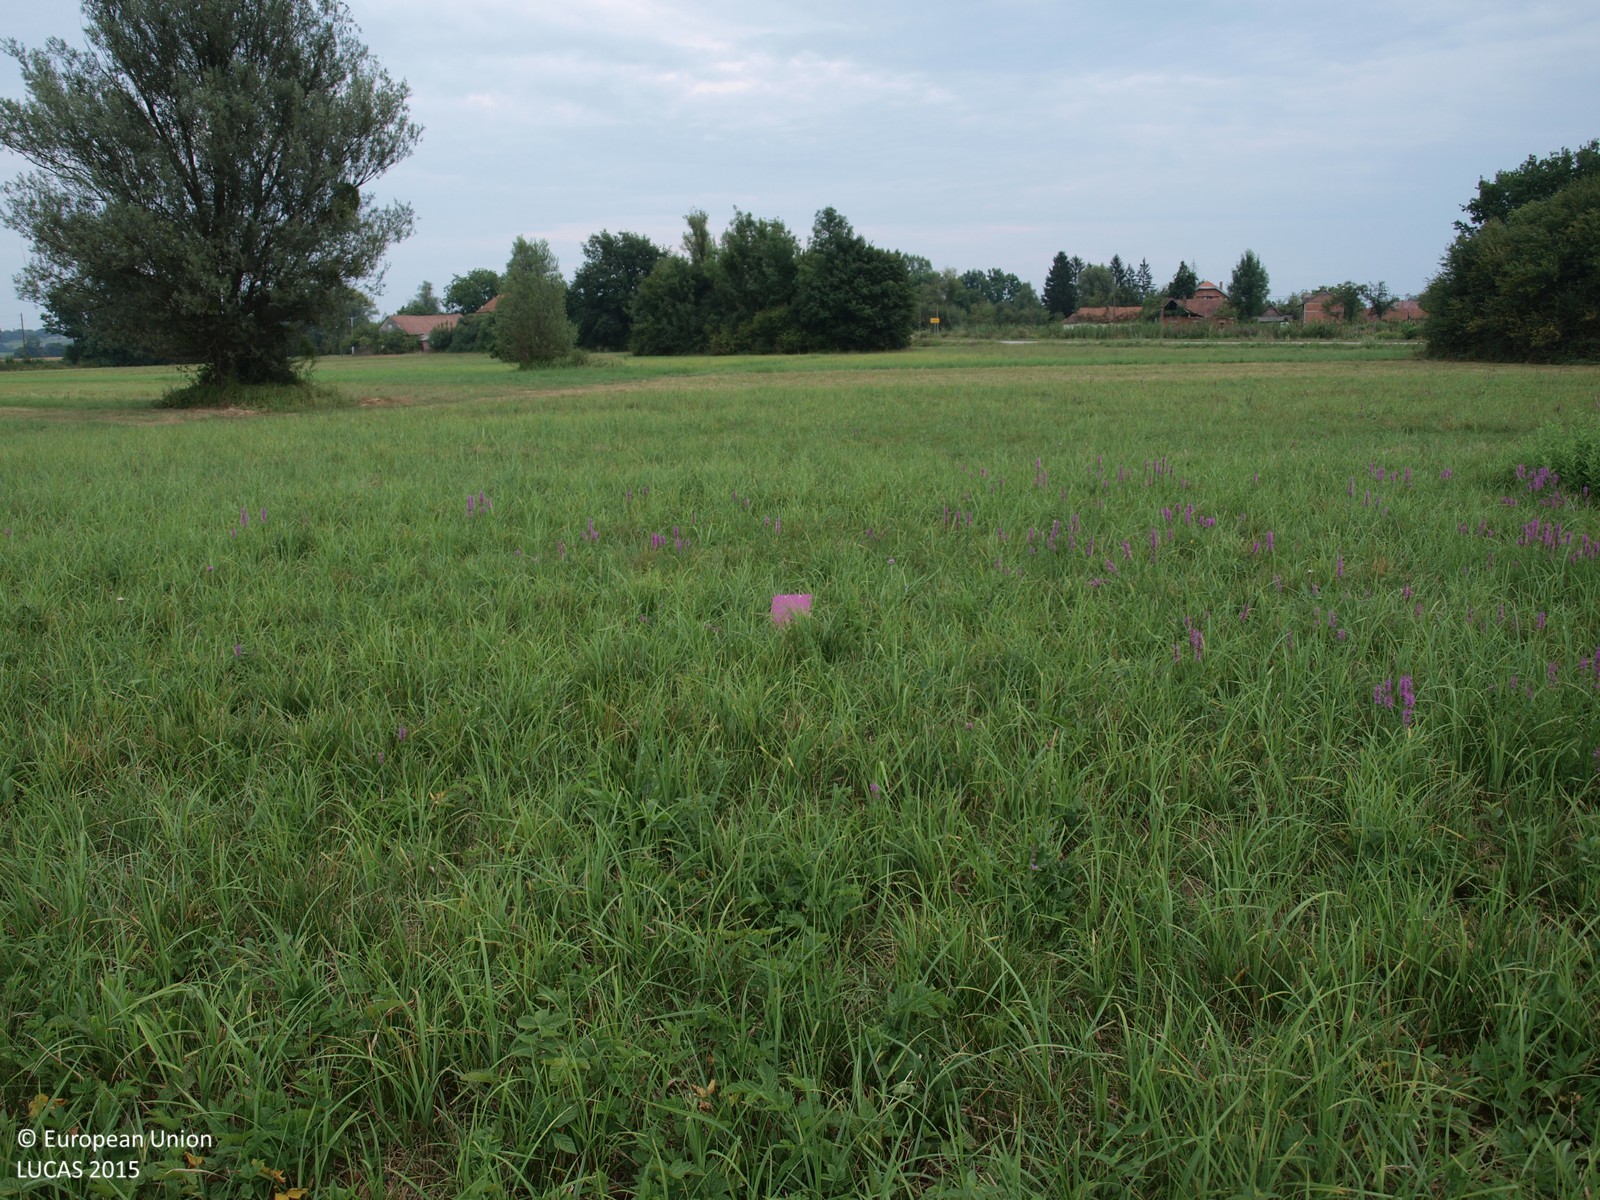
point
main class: Grassland
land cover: Grassland without tree/shrub cover
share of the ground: > 75 %
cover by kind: herbaceous plants 100 %
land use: Agriculture (excluding fallow land and kitchen gardens)
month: August
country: HR
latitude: 46.0123
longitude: 16.4443
